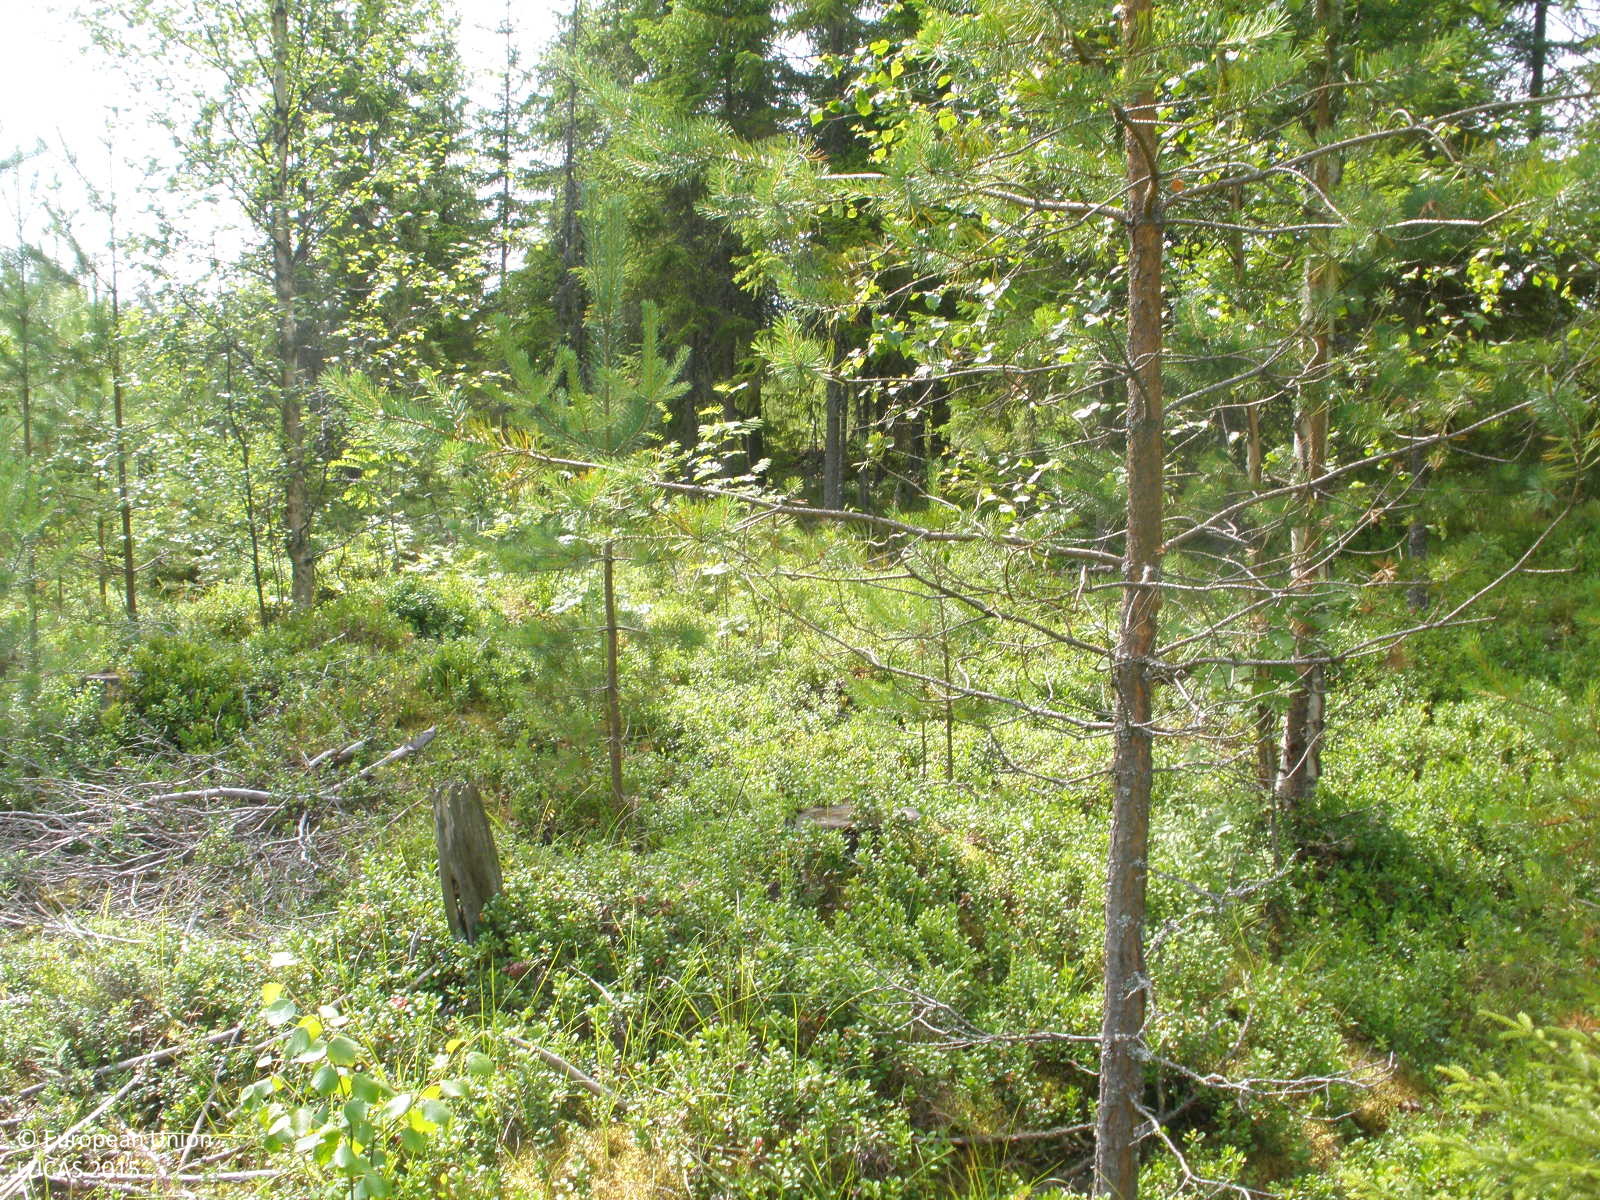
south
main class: Woodland
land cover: Pine dominated mixed woodland
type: boreal forest
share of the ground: 50 - 75 %
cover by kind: coniferous forest trees 40 %, broadleaved forest trees 30 %, herbaceous plants 15 %, lichens and mosses 10 %, shrubs 5 %
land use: Forestry
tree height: < 5 m
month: July
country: FI
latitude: 61.4877
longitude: 24.8095
